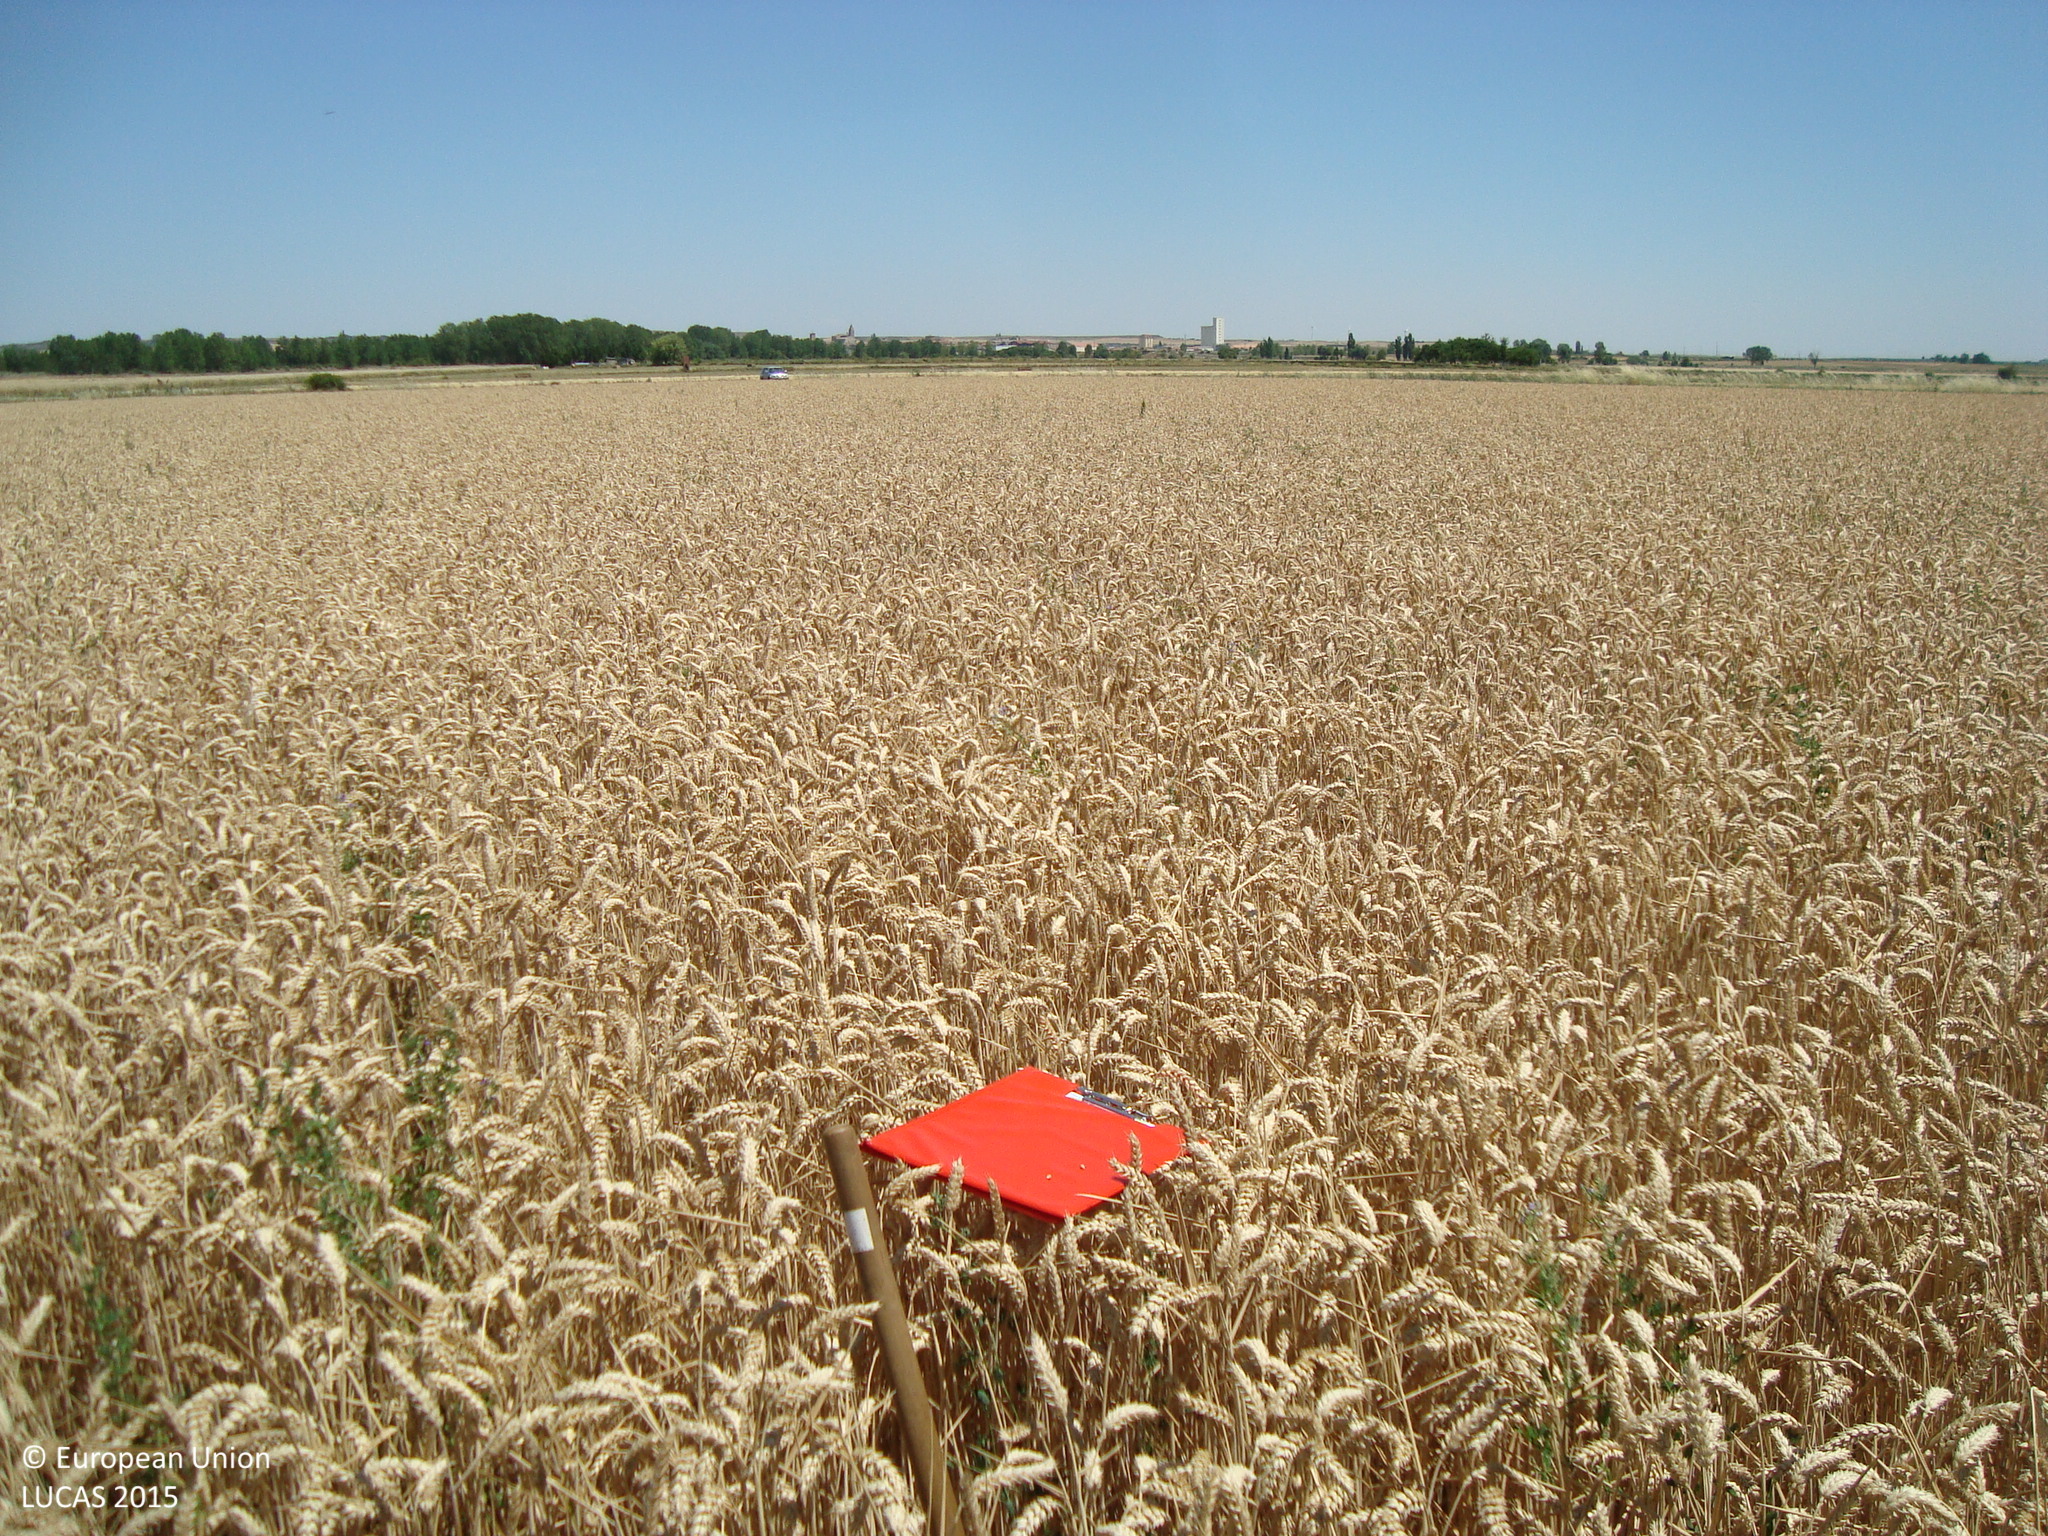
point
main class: Cropland
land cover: Common wheat
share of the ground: > 75 %
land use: Agriculture (excluding fallow land and kitchen gardens)
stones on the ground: < 10 %
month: July
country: ES
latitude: 42.1566
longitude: -4.7316
